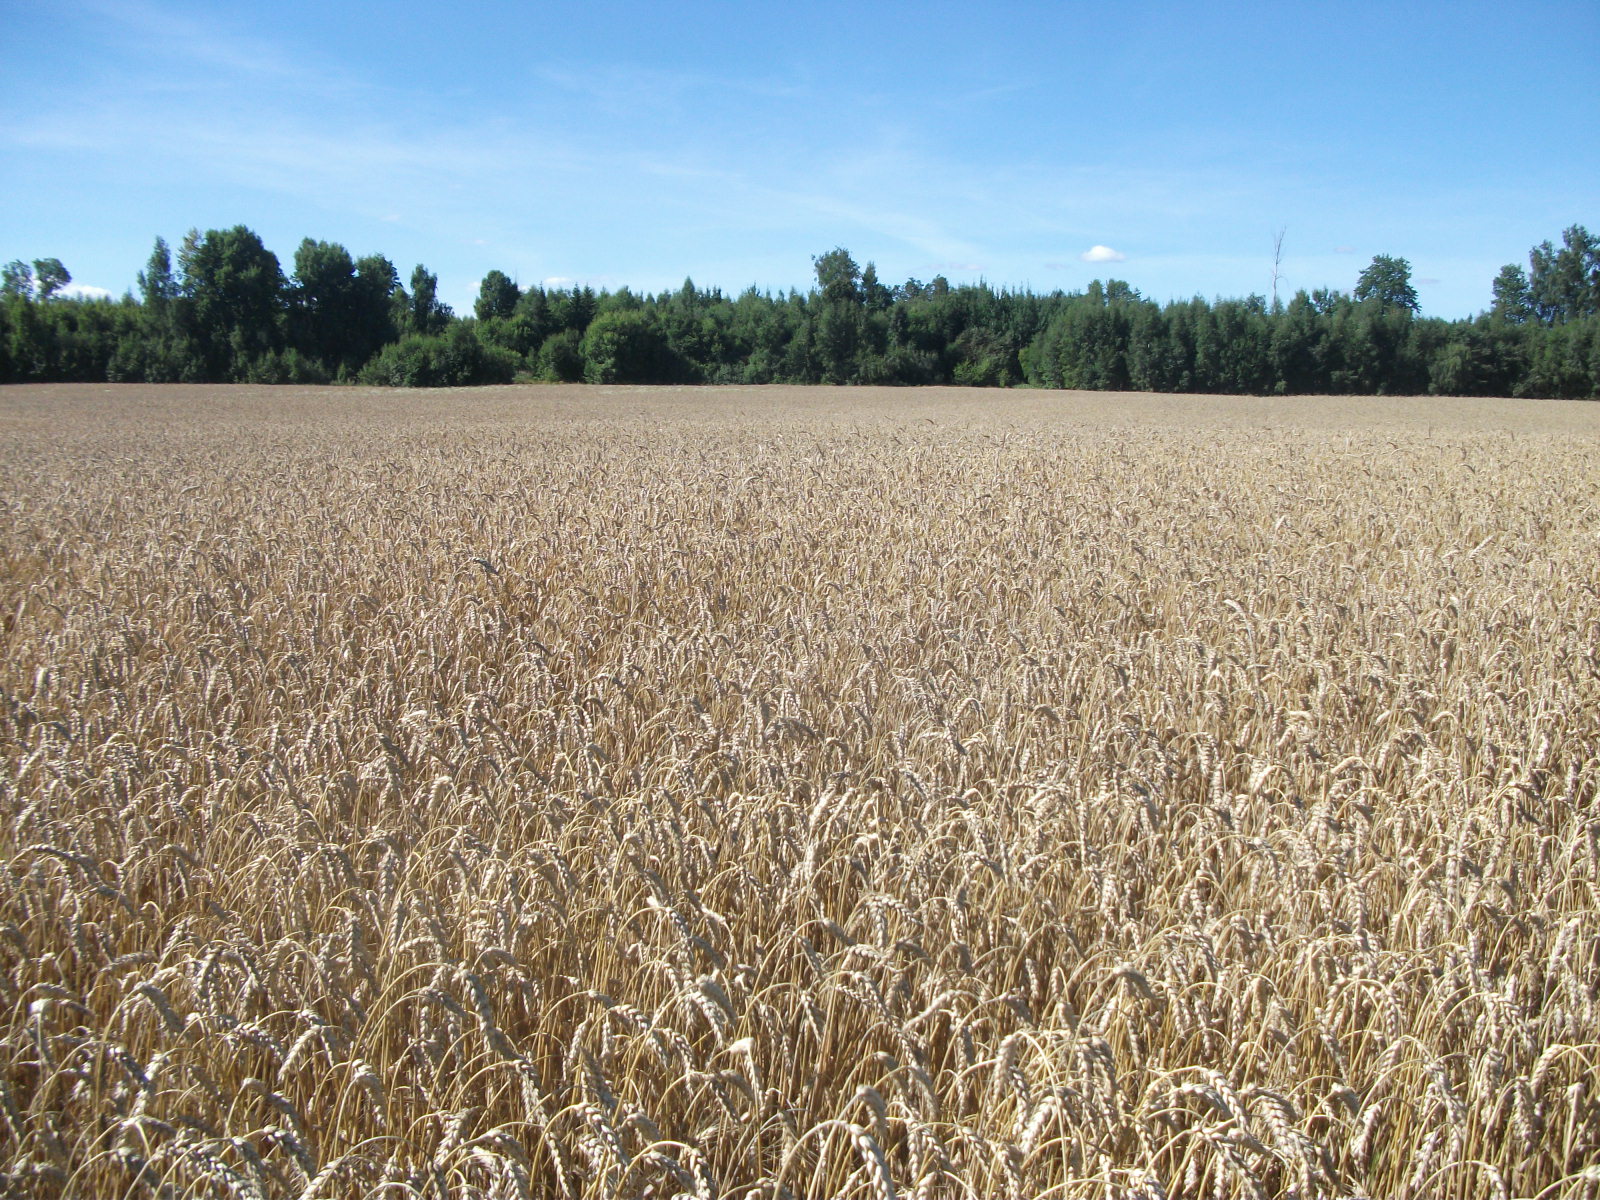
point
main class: Cropland
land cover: Common wheat
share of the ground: > 75 %
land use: Agriculture (excluding fallow land and kitchen gardens)
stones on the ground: < 10 %
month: August
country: LV
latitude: 56.6913
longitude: 26.3561
